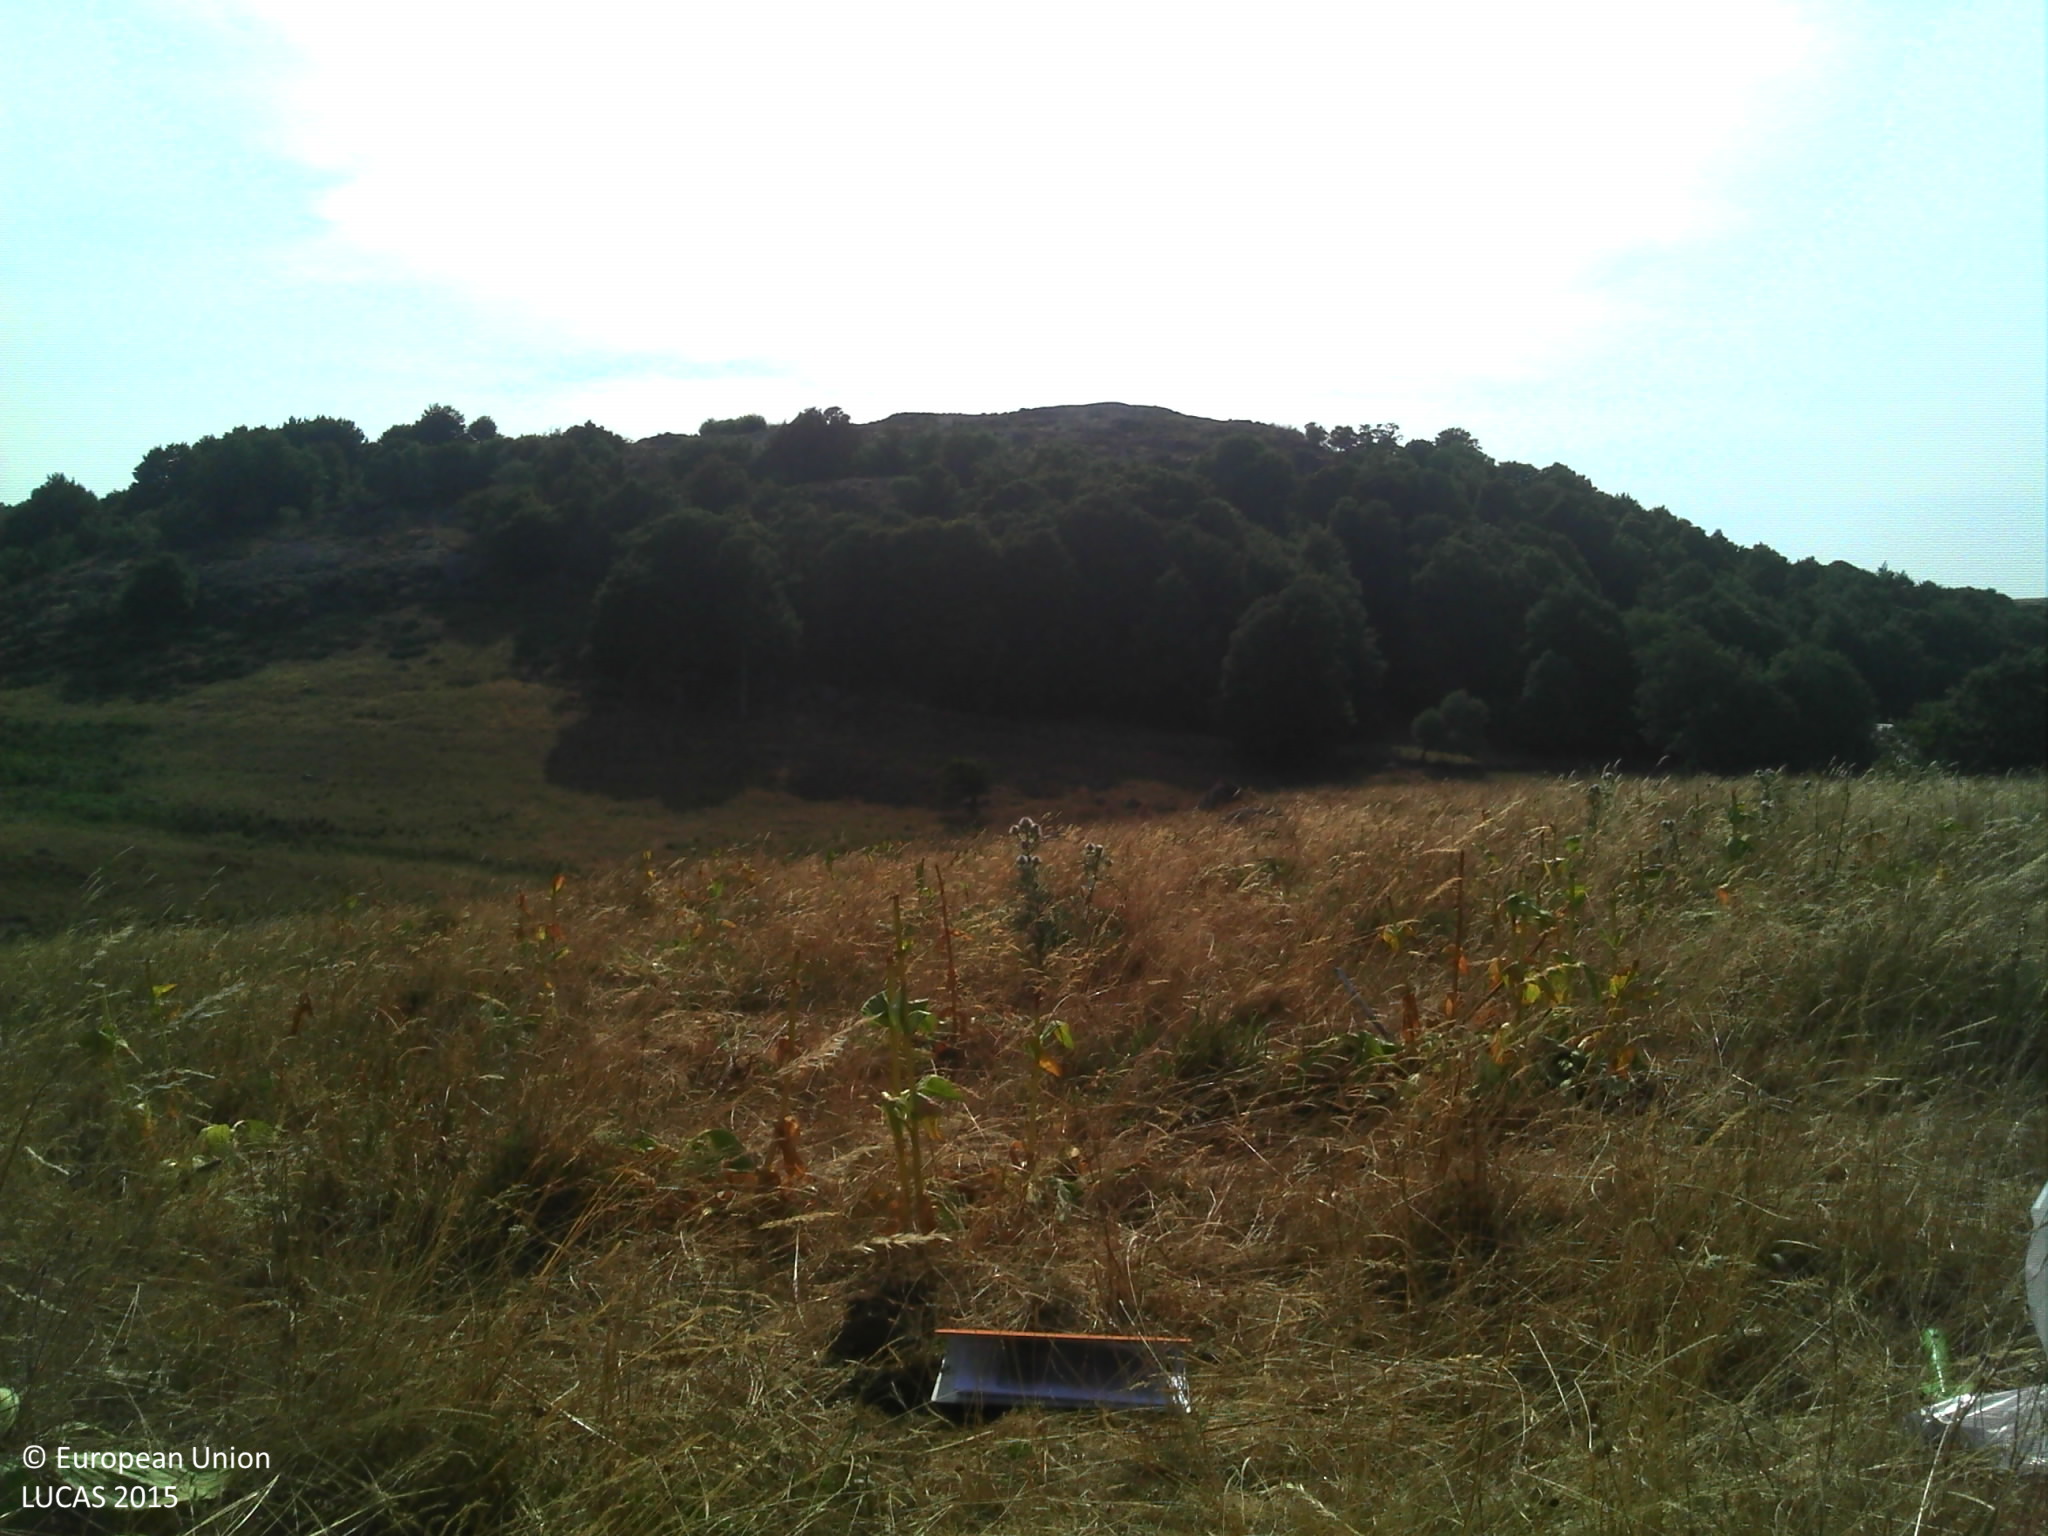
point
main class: Grassland
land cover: Grassland without tree/shrub cover
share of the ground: > 75 %
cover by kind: herbaceous plants 95 %, shrubs 5 %
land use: Agriculture (excluding fallow land and kitchen gardens)
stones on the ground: 10 - 25 %
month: July
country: FR
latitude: 44.6589
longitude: 3.0295
